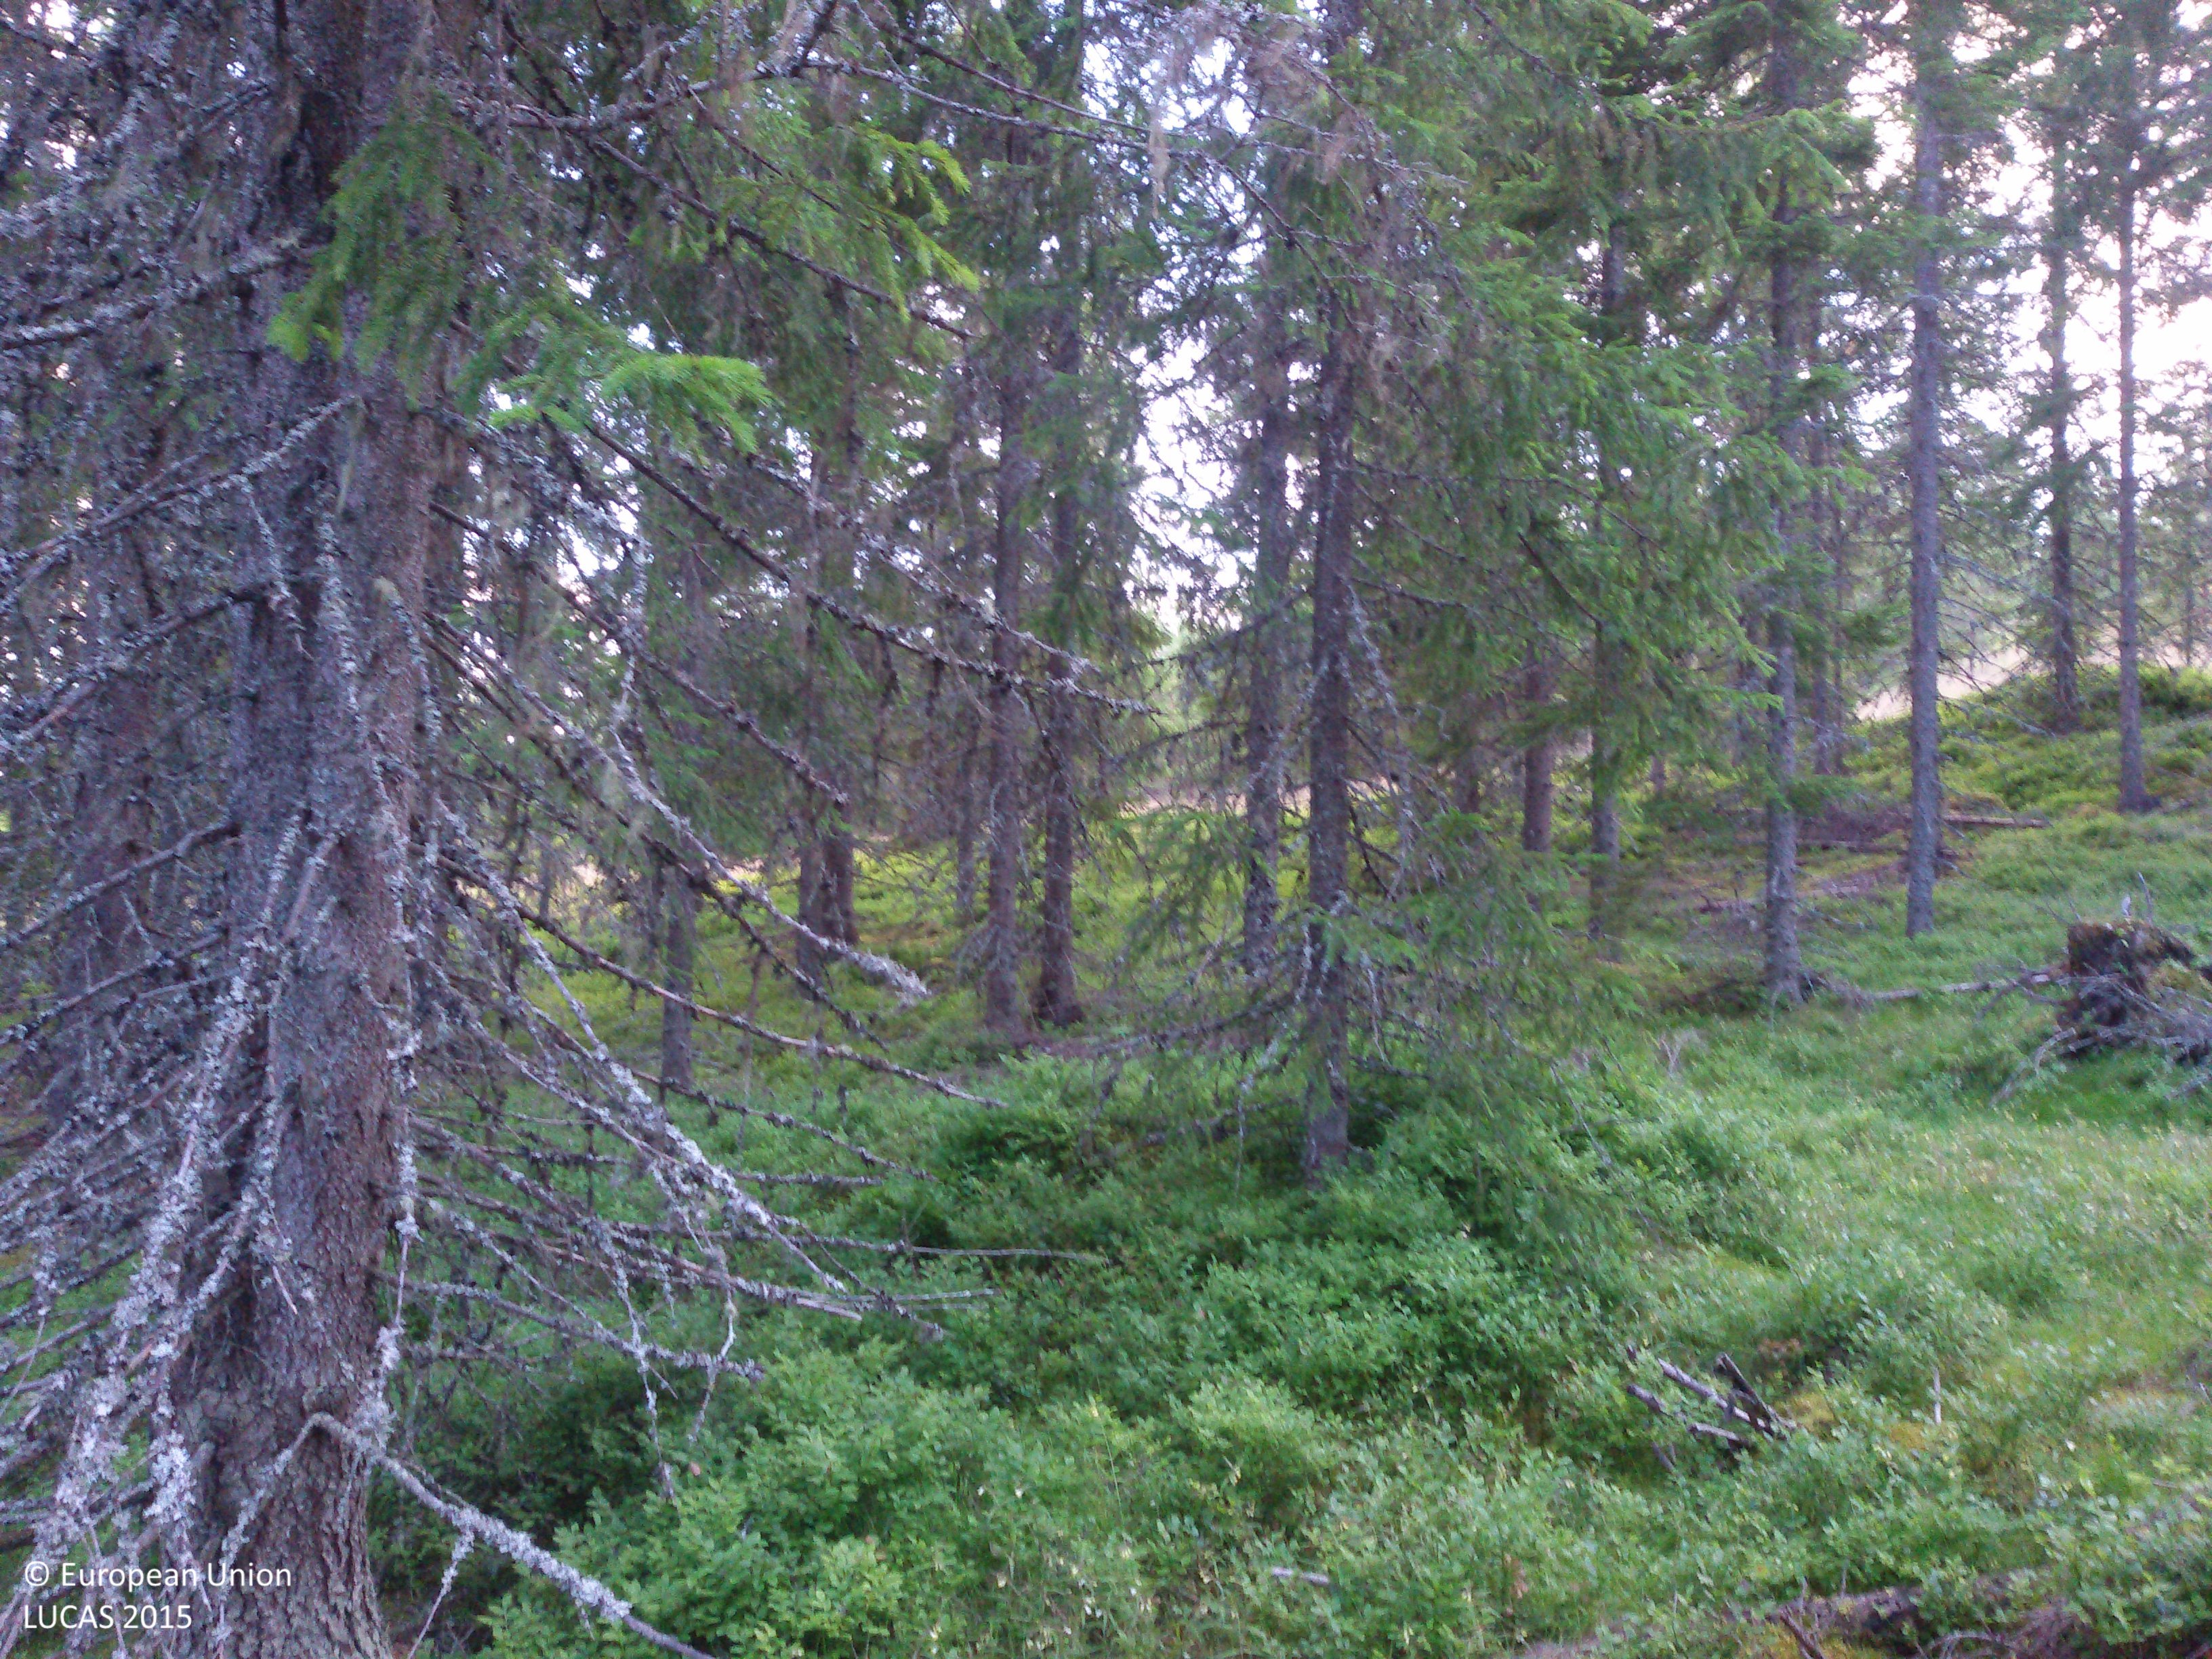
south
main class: Woodland
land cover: Spruce dominated coniferous woodland
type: boreal forest
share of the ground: 50 - 75 %
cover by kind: coniferous forest trees 70 %, herbaceous plants 30 %
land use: Forestry
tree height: > 5 m
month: July
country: SE
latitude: 60.5623
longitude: 14.9673
